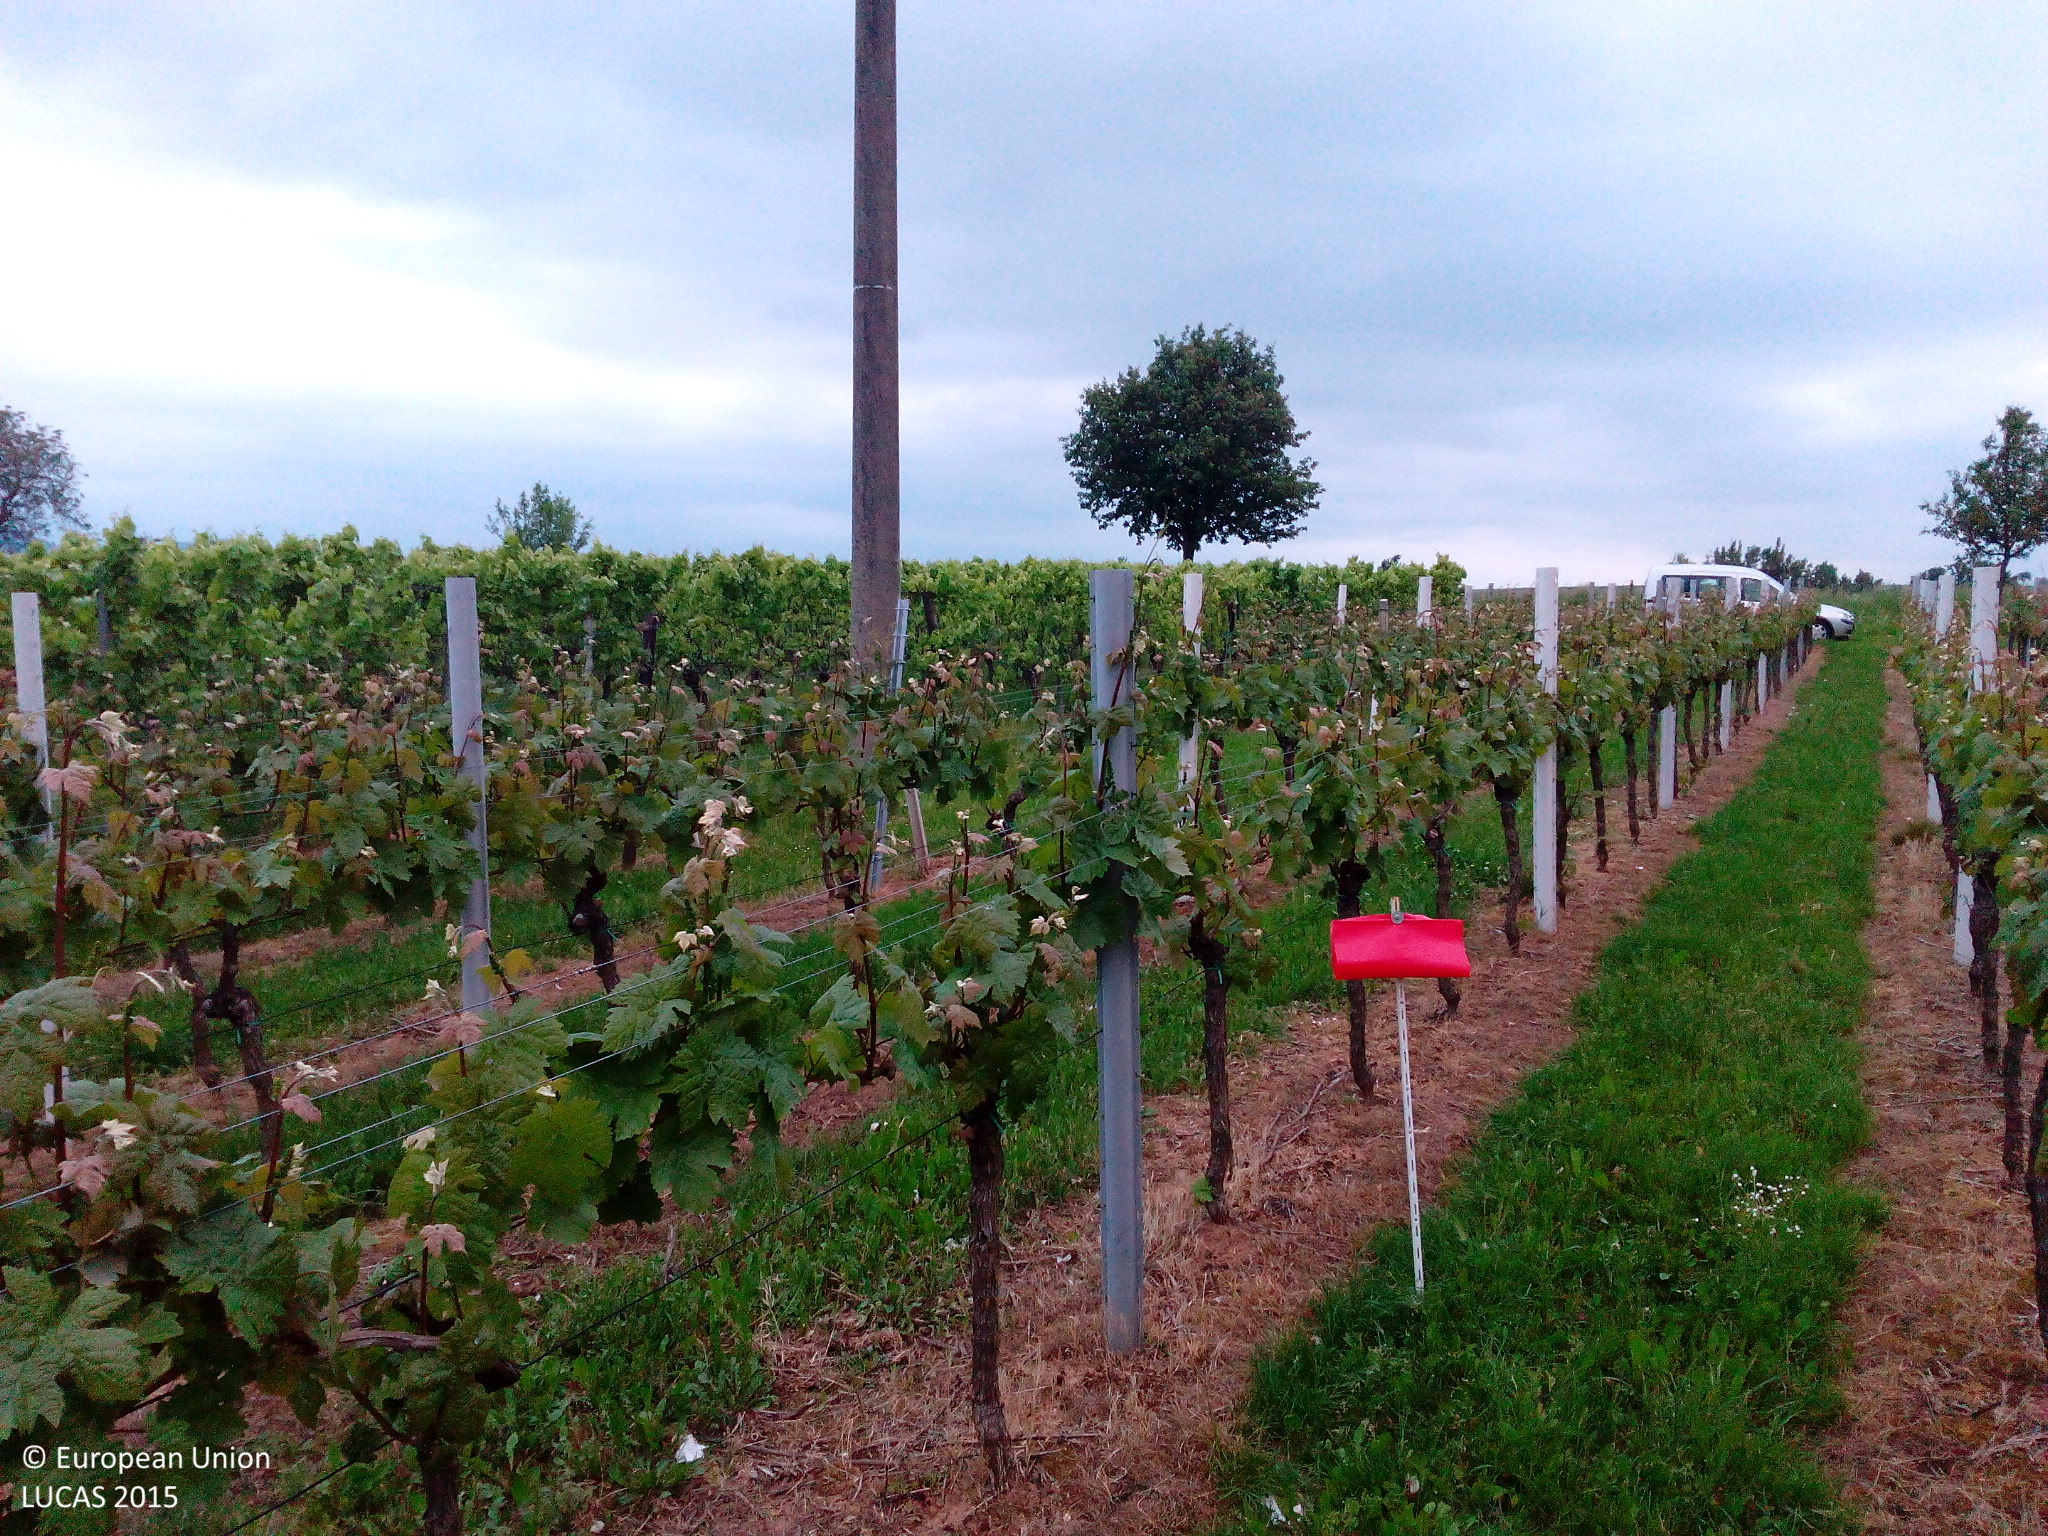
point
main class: Cropland
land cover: Vineyards
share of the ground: 25 - 50 %
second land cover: Grassland without tree/shrub cover
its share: 25 - 50 %
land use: Agriculture (excluding fallow land and kitchen gardens)
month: May
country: DE
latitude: 49.1424
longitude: 8.0678
